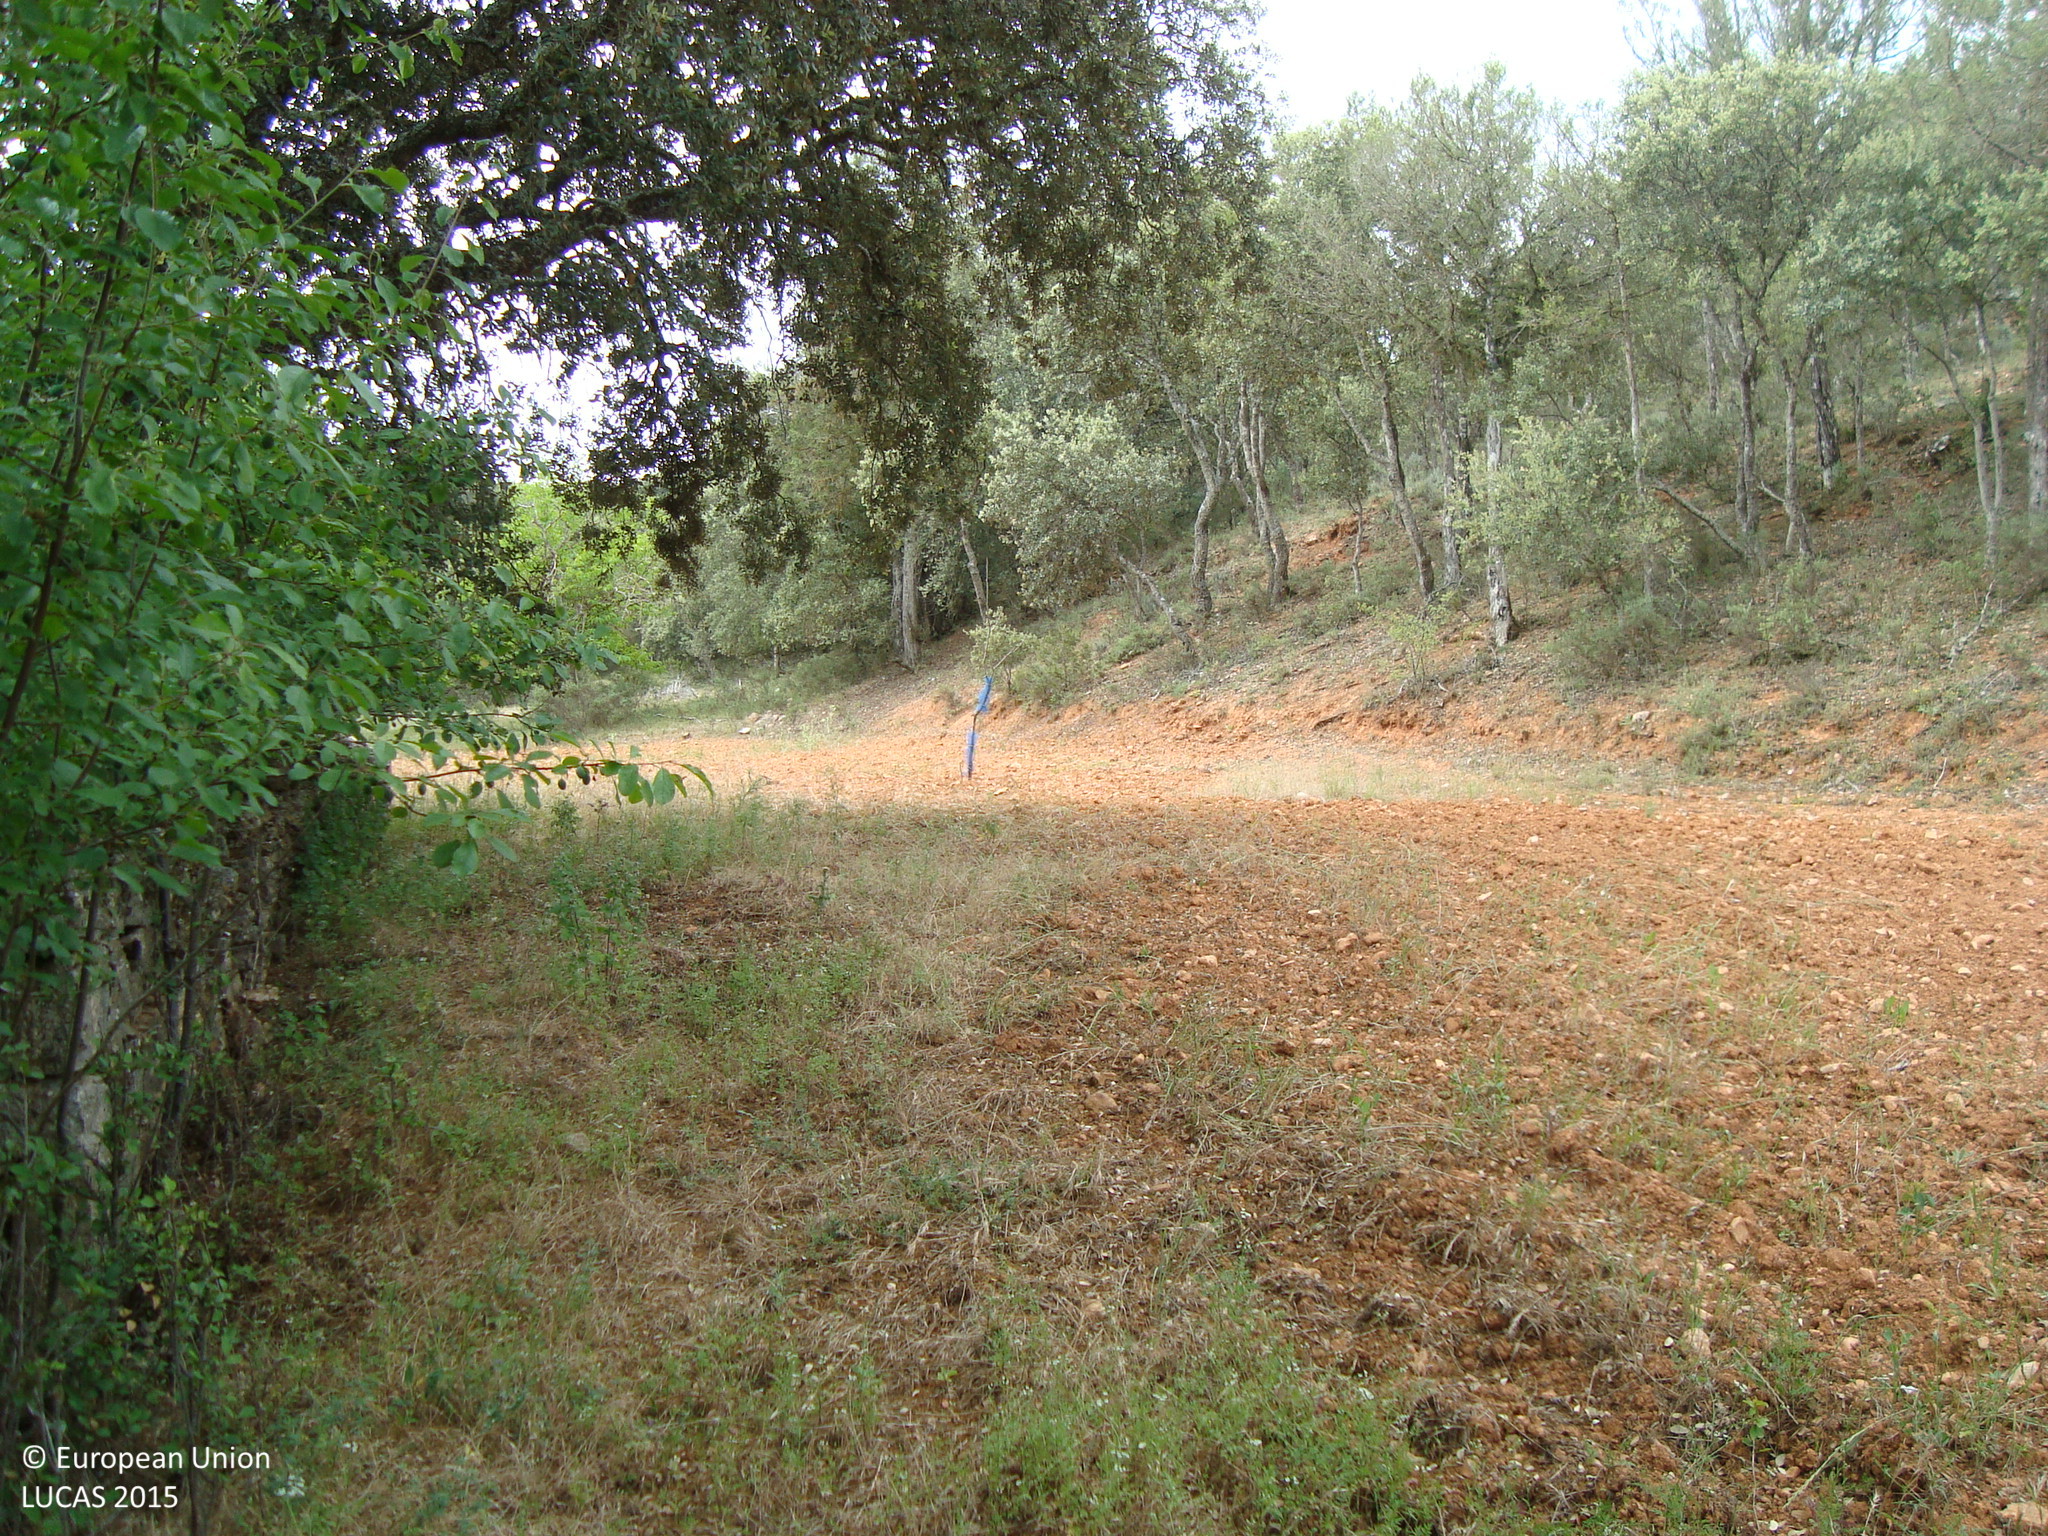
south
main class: Cropland
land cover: Nuts trees
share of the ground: 25 - 50 %
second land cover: Grassland without tree/shrub cover
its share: > 75 %
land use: Agriculture (excluding fallow land and kitchen gardens)
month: June
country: ES
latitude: 41.9624
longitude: -3.6536
